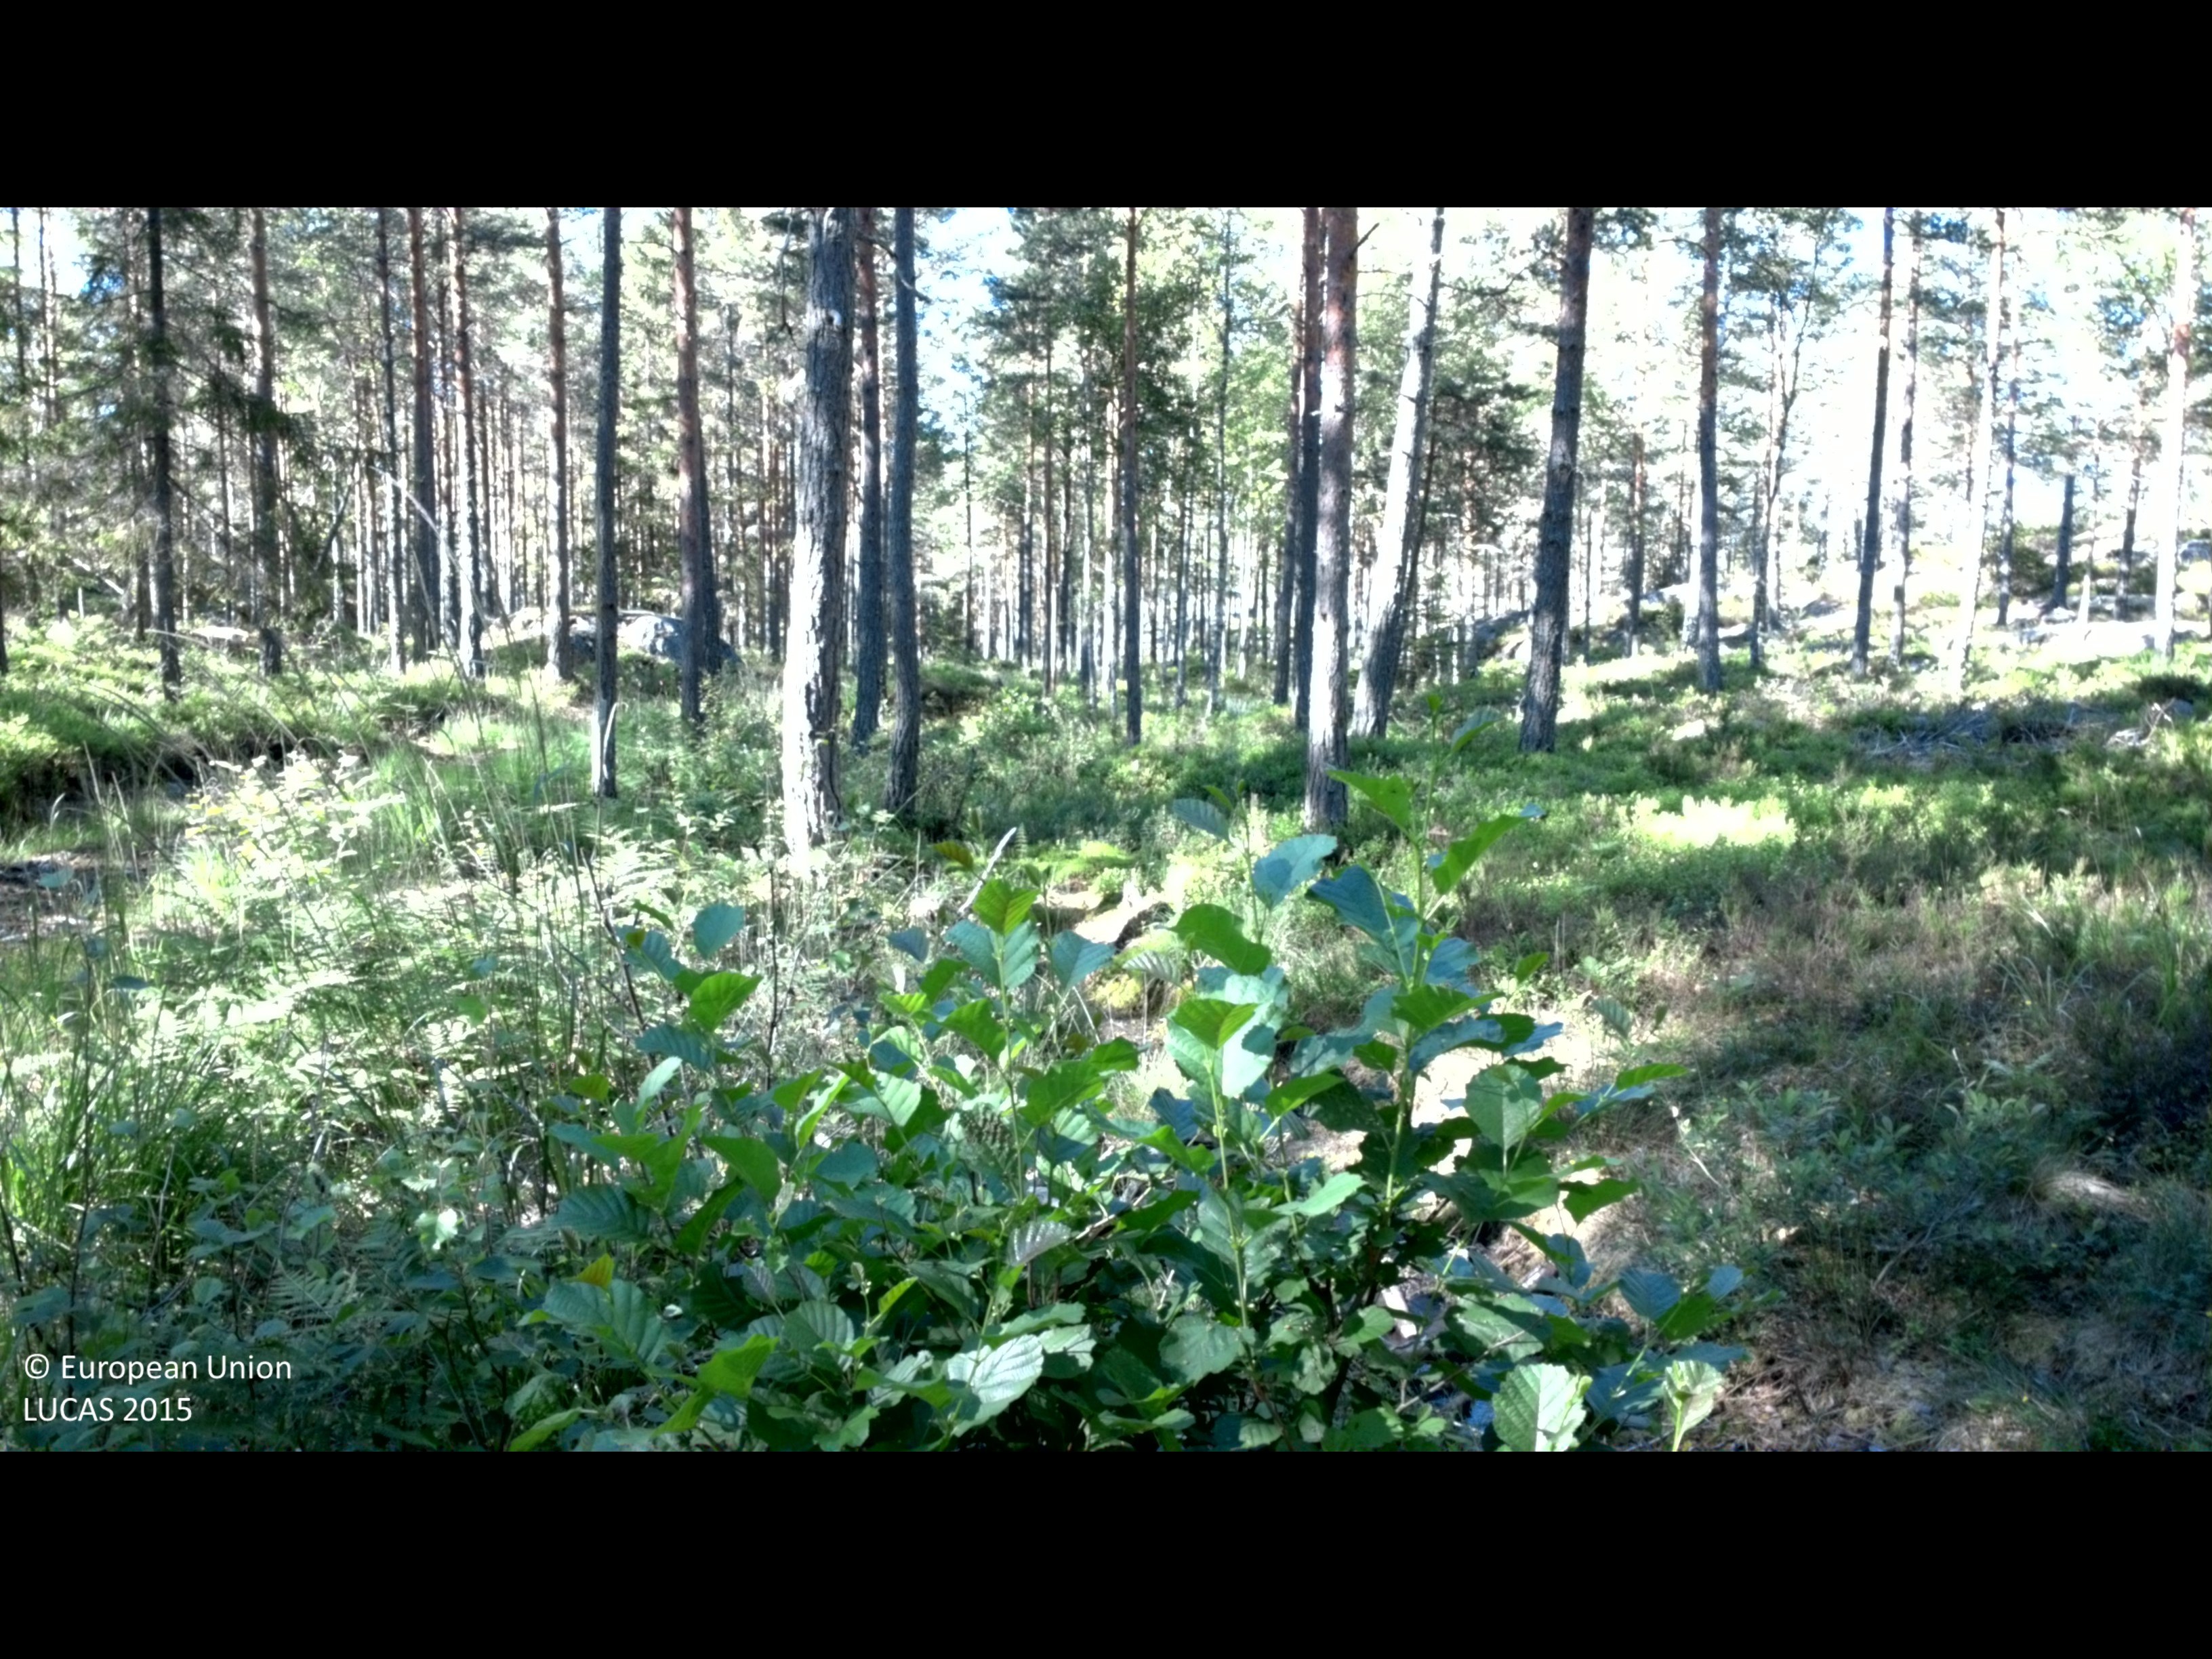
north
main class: Woodland
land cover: Pine dominated mixed woodland
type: boreal forest
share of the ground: 50 - 75 %
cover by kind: coniferous forest trees 50 %, shrubs 25 %, broadleaved forest trees 20 %, herbaceous plants 5 %
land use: Forestry
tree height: > 5 m
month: July
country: SE
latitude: 58.2351
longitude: 16.6566
